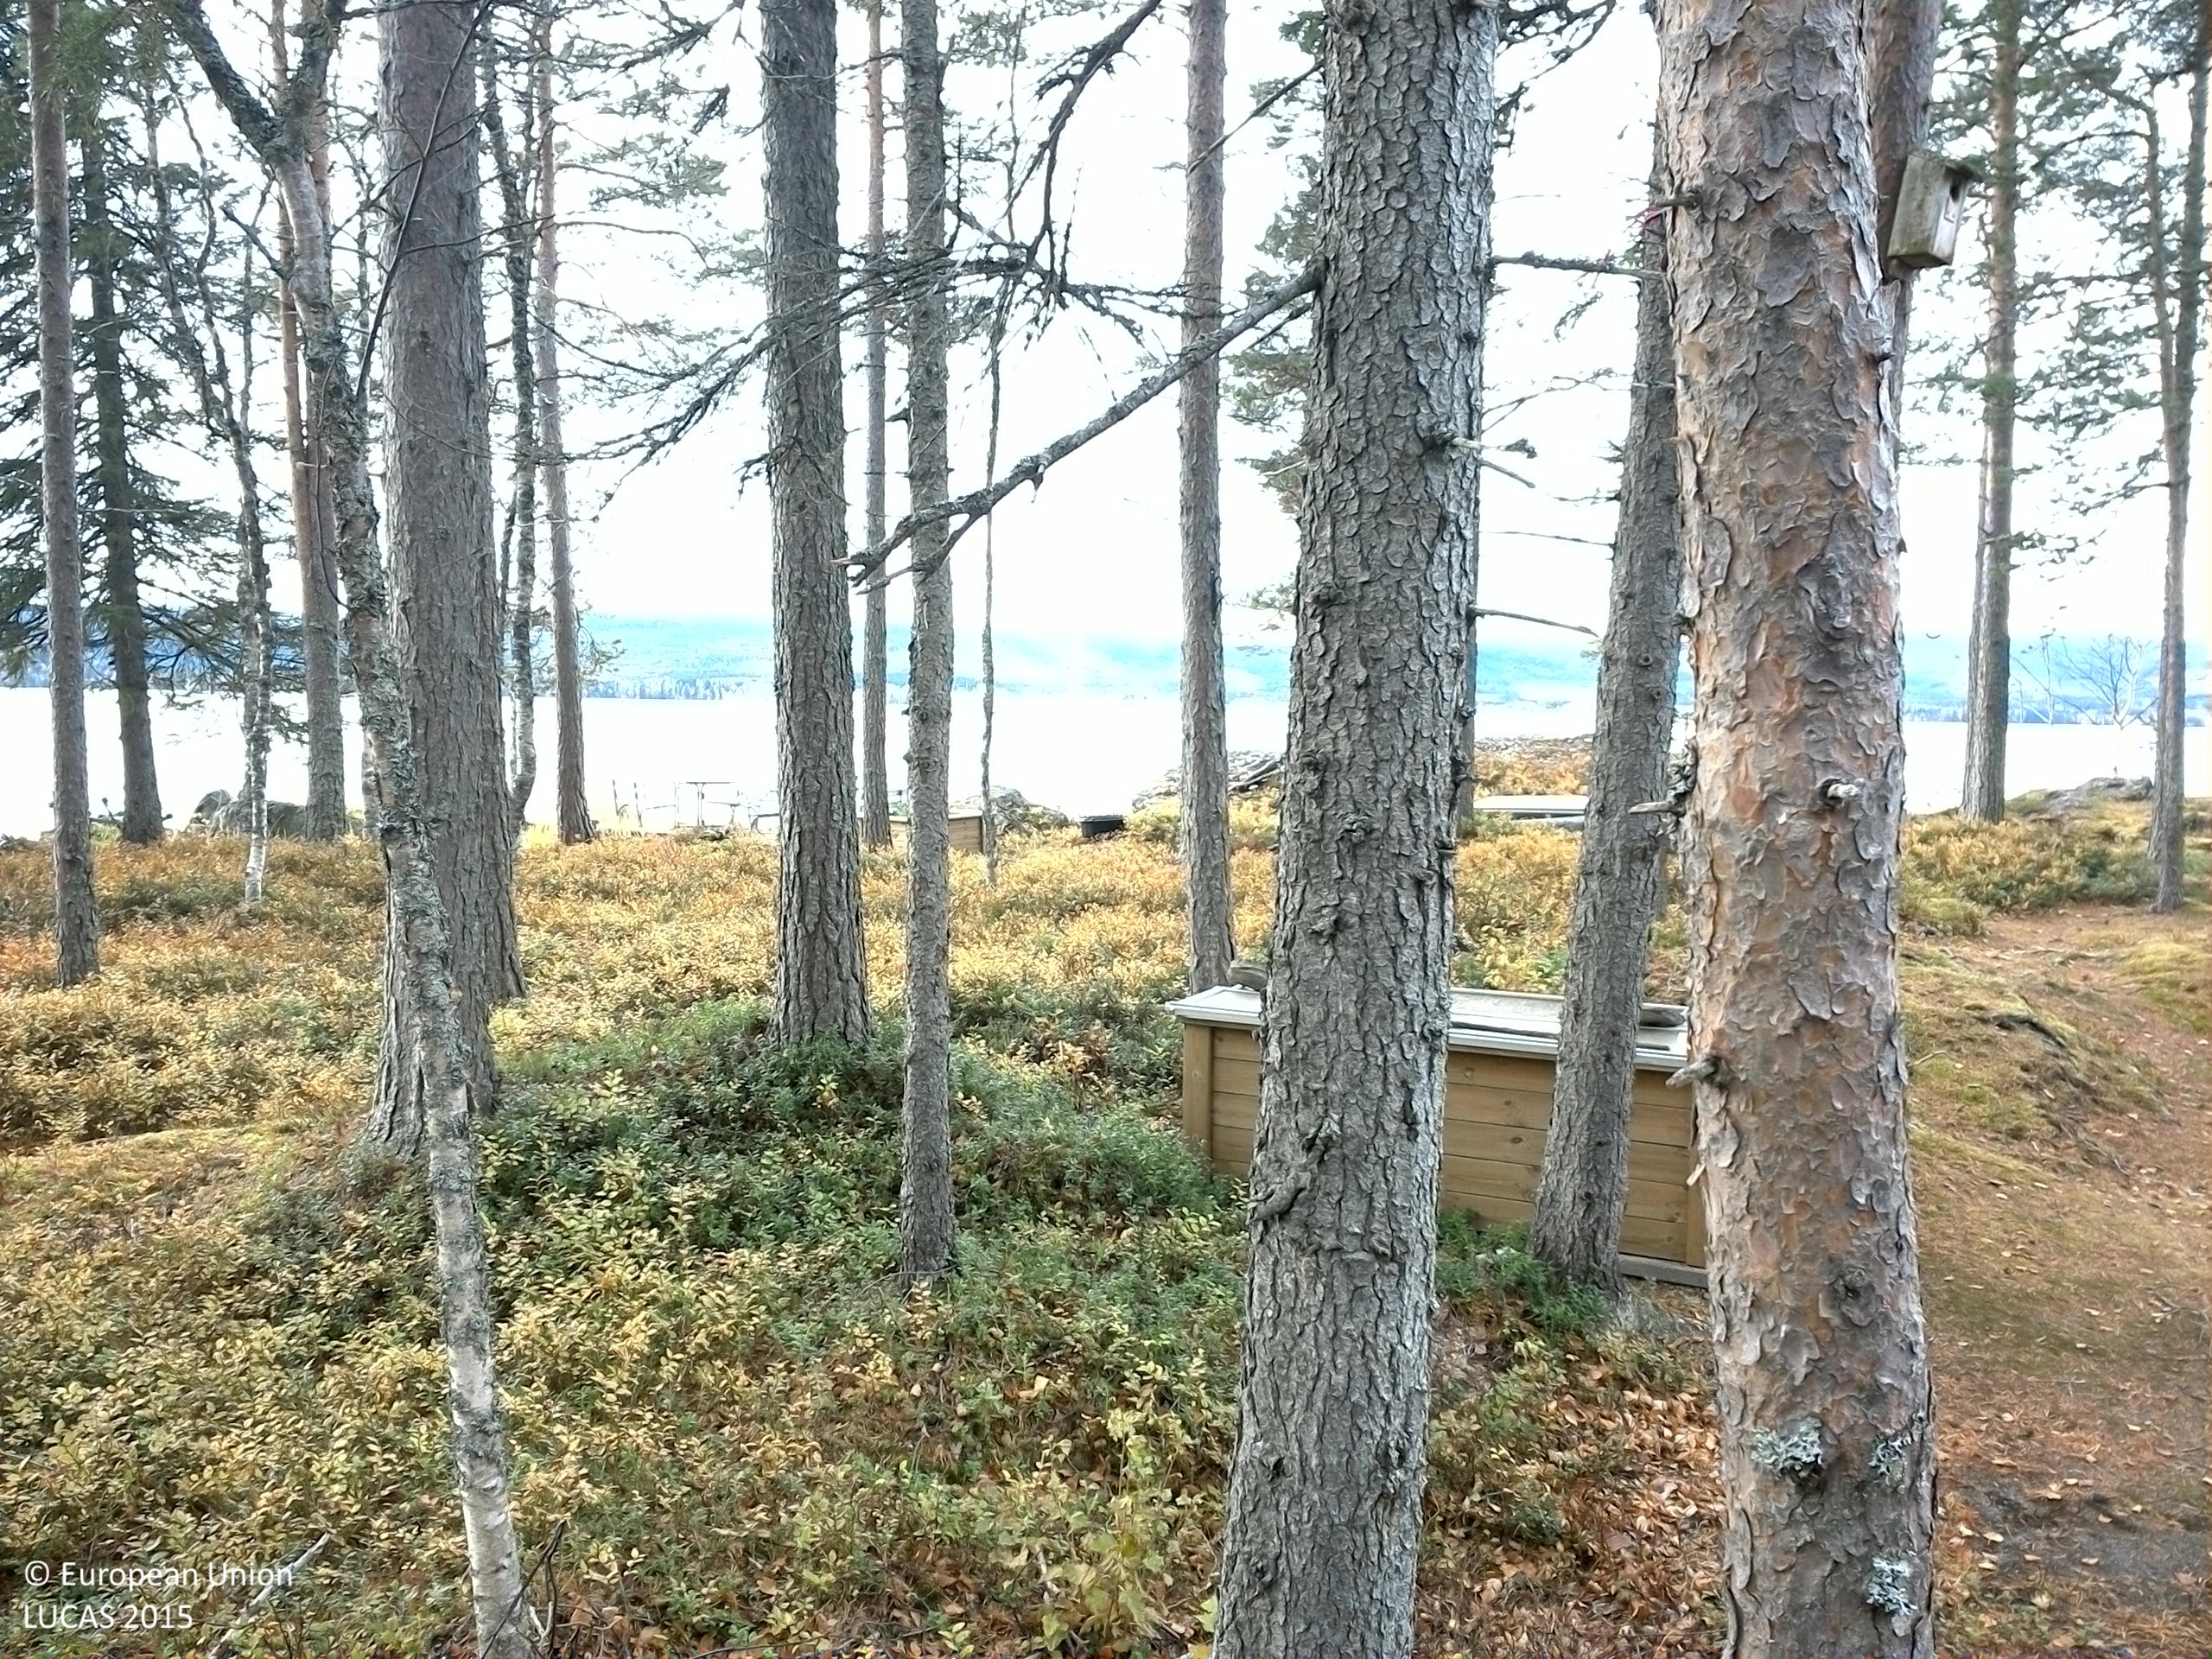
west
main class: Woodland
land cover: Pine dominated mixed woodland
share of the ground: 25 - 50 %
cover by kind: shrubs 50 %, coniferous forest trees 15 %, broadleaved forest trees 10 %, lichens and mosses 10 %, consolidated bare surface 5 %
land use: Residential
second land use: Forestry
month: October
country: SE
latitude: 64.0533
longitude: 15.8916
